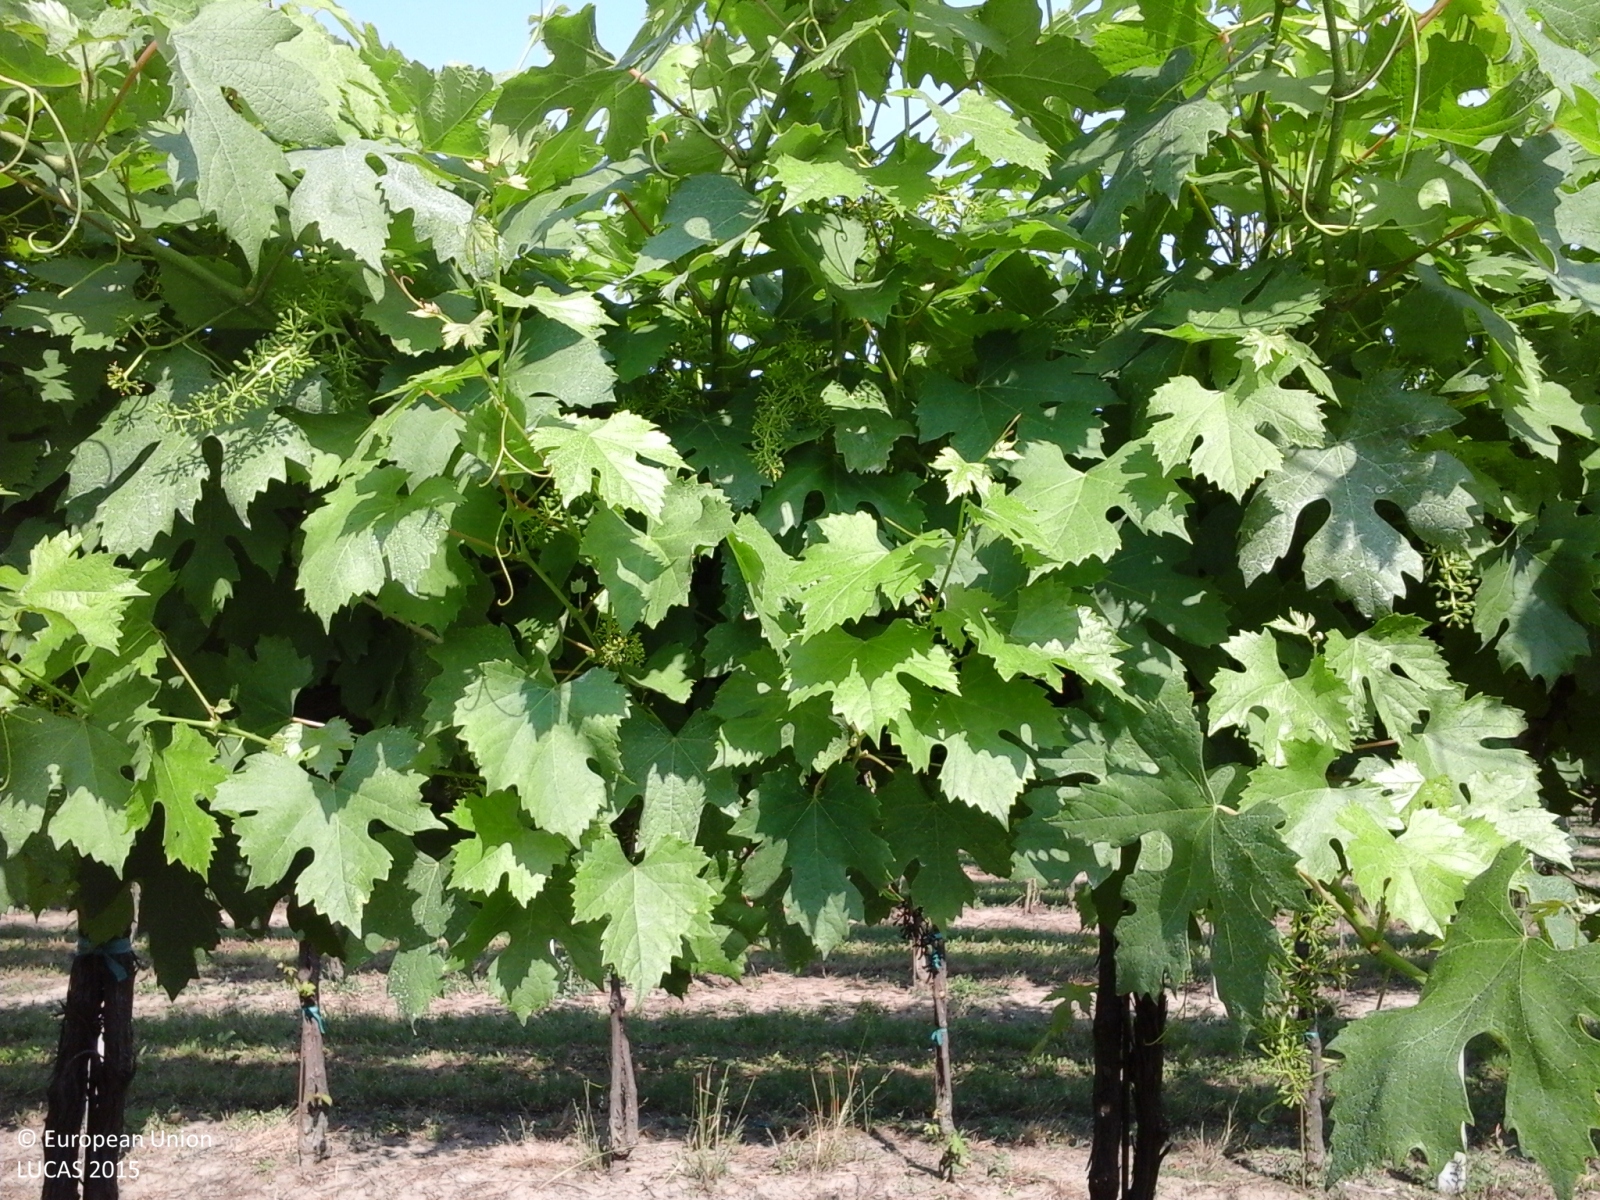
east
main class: Cropland
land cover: Vineyards
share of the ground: 25 - 50 %
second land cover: Grassland without tree/shrub cover
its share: 50 - 75 %
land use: Agriculture (excluding fallow land and kitchen gardens)
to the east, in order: Vineyards; Grassland without tree/shrub cover; Artificial constructions in urban areas; Grassland without tree/shrub cover; Vineyards
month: May
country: IT
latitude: 44.7627
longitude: 10.7439
